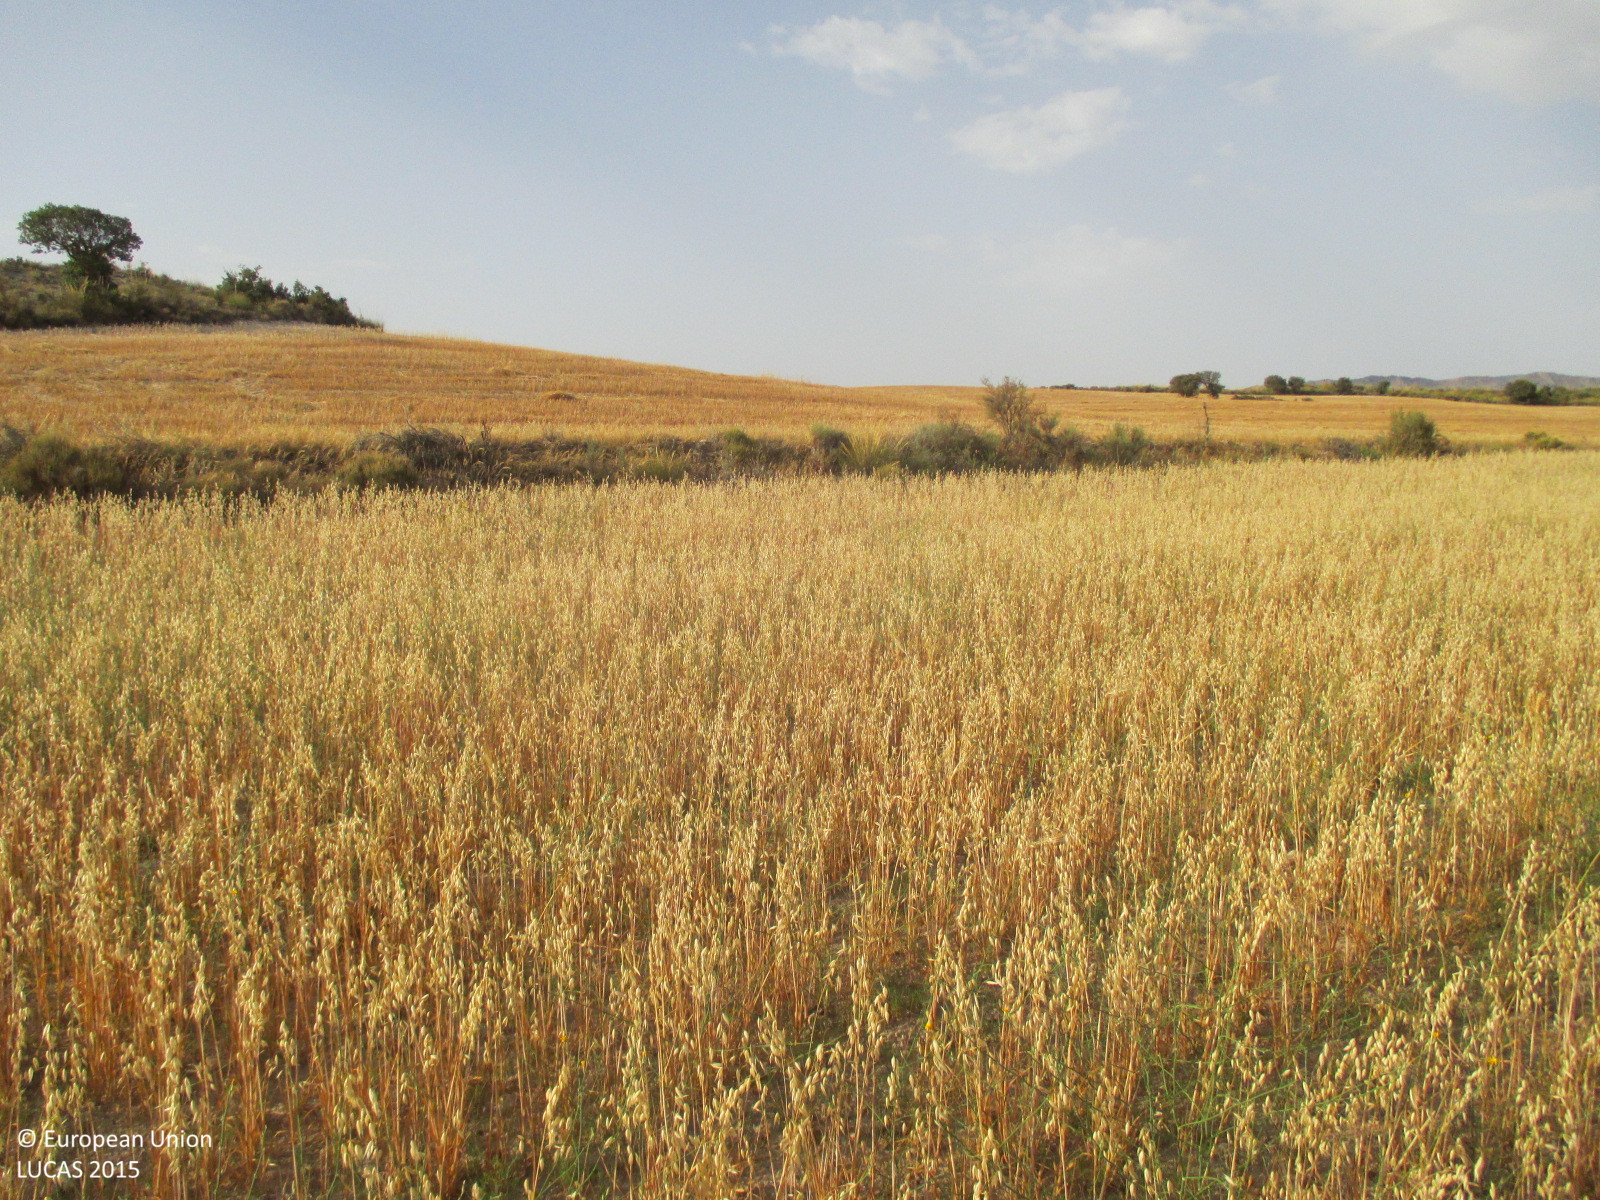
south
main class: Cropland
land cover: Oats
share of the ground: 50 - 75 %
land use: Agriculture (excluding fallow land and kitchen gardens)
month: July
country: ES
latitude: 37.7578
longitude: -2.3944
